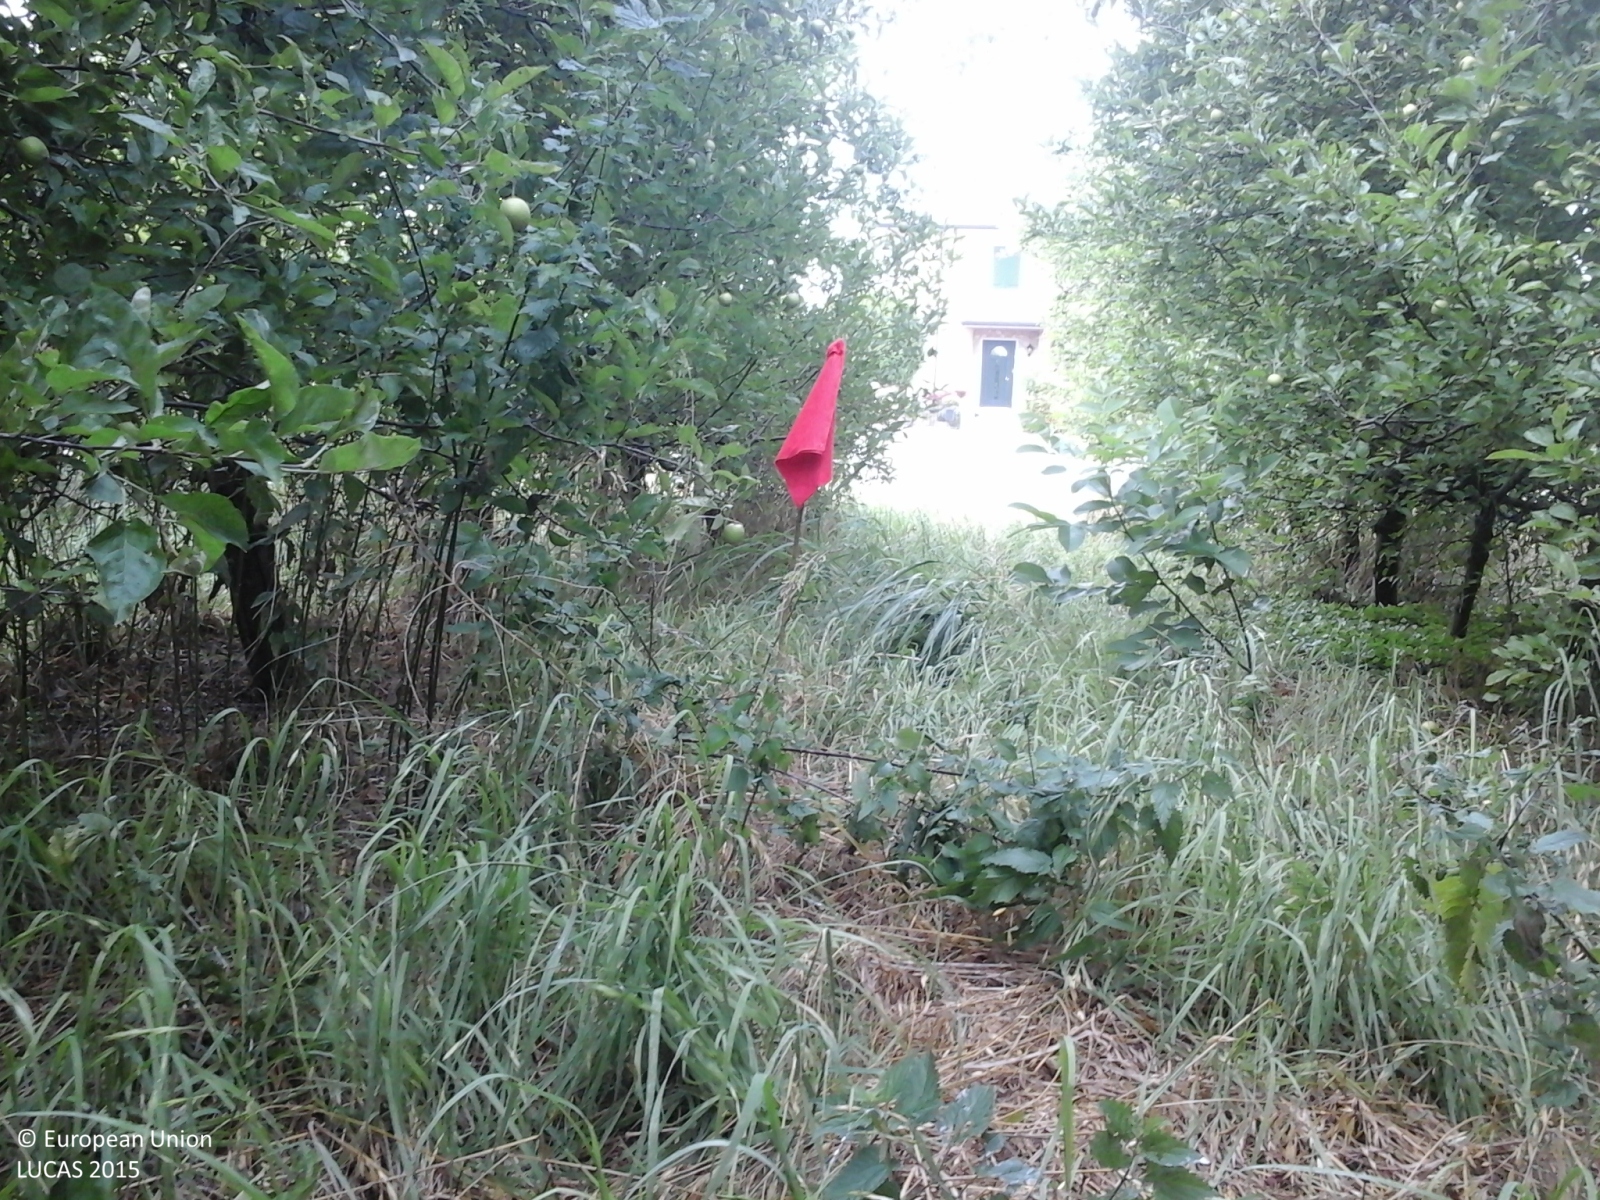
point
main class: Cropland
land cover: Apple fruit
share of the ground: 50 - 75 %
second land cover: Grassland without tree/shrub cover
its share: > 75 %
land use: Agriculture (excluding fallow land and kitchen gardens)
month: June
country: IT
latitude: 45.3349
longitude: 11.2356
